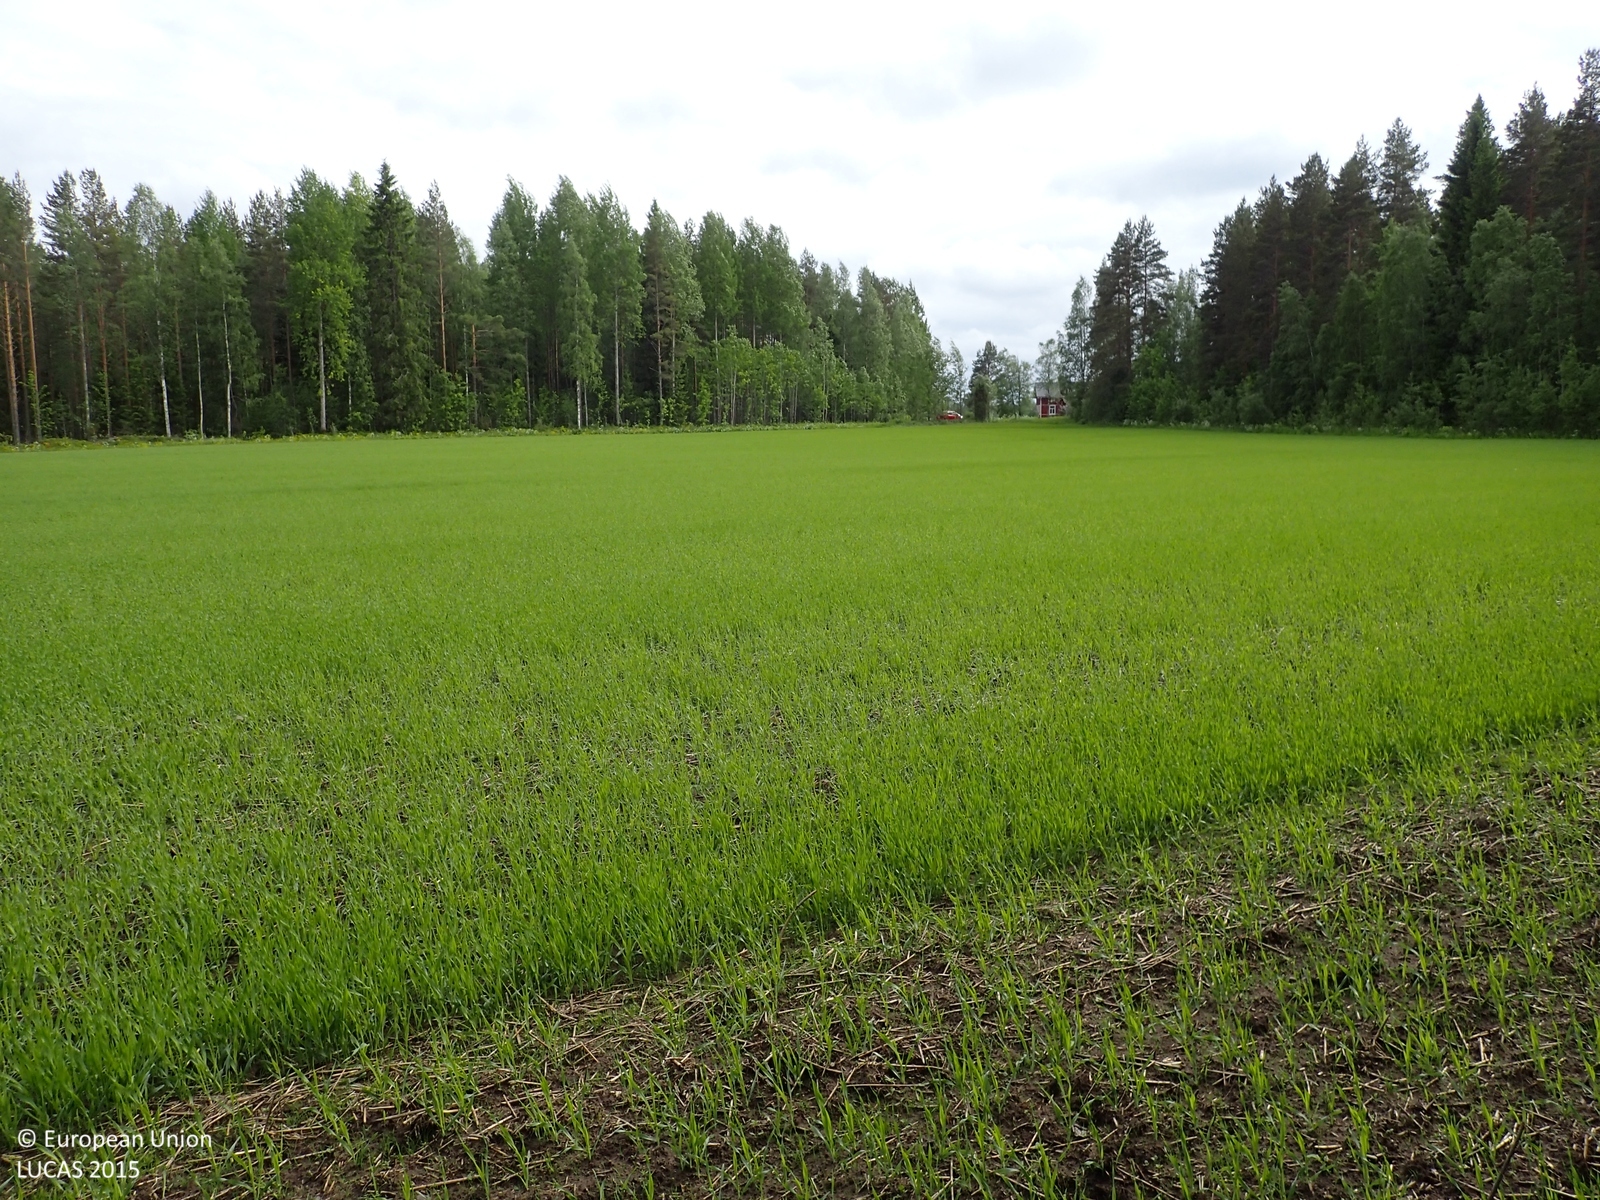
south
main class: Cropland
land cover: Barley
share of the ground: > 75 %
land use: Agriculture (excluding fallow land and kitchen gardens)
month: June
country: FI
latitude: 62.3381
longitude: 21.6894
